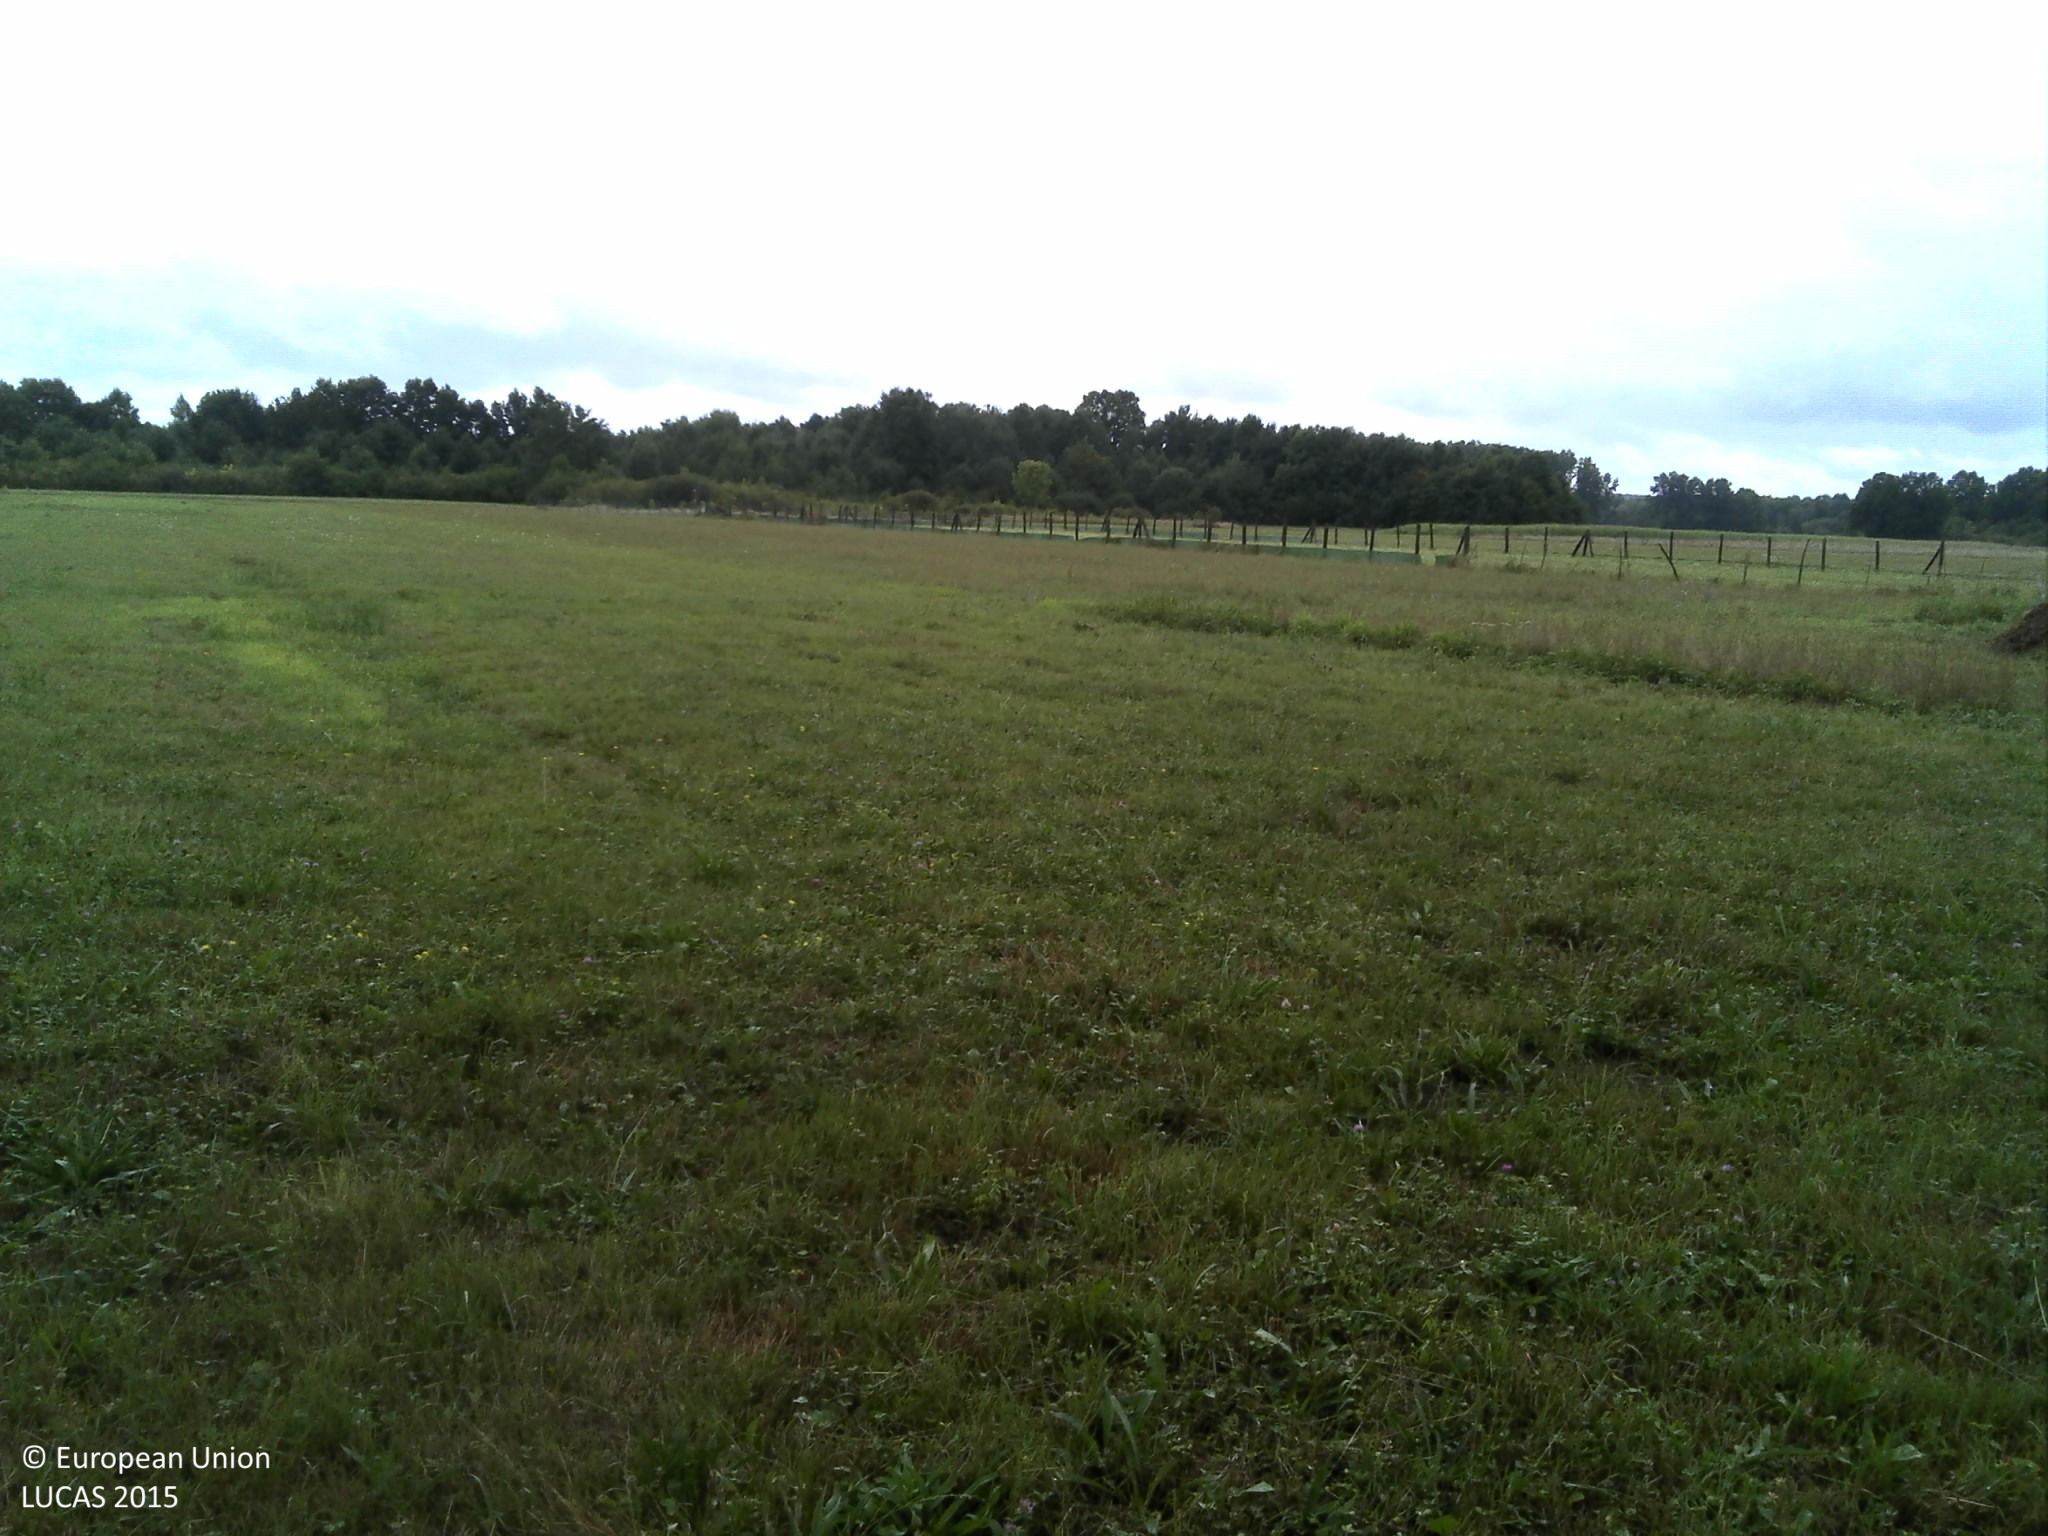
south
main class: Cropland
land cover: Clovers
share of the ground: > 75 %
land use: Agriculture (excluding fallow land and kitchen gardens)
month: August
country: HR
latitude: 45.4788
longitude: 15.6636
